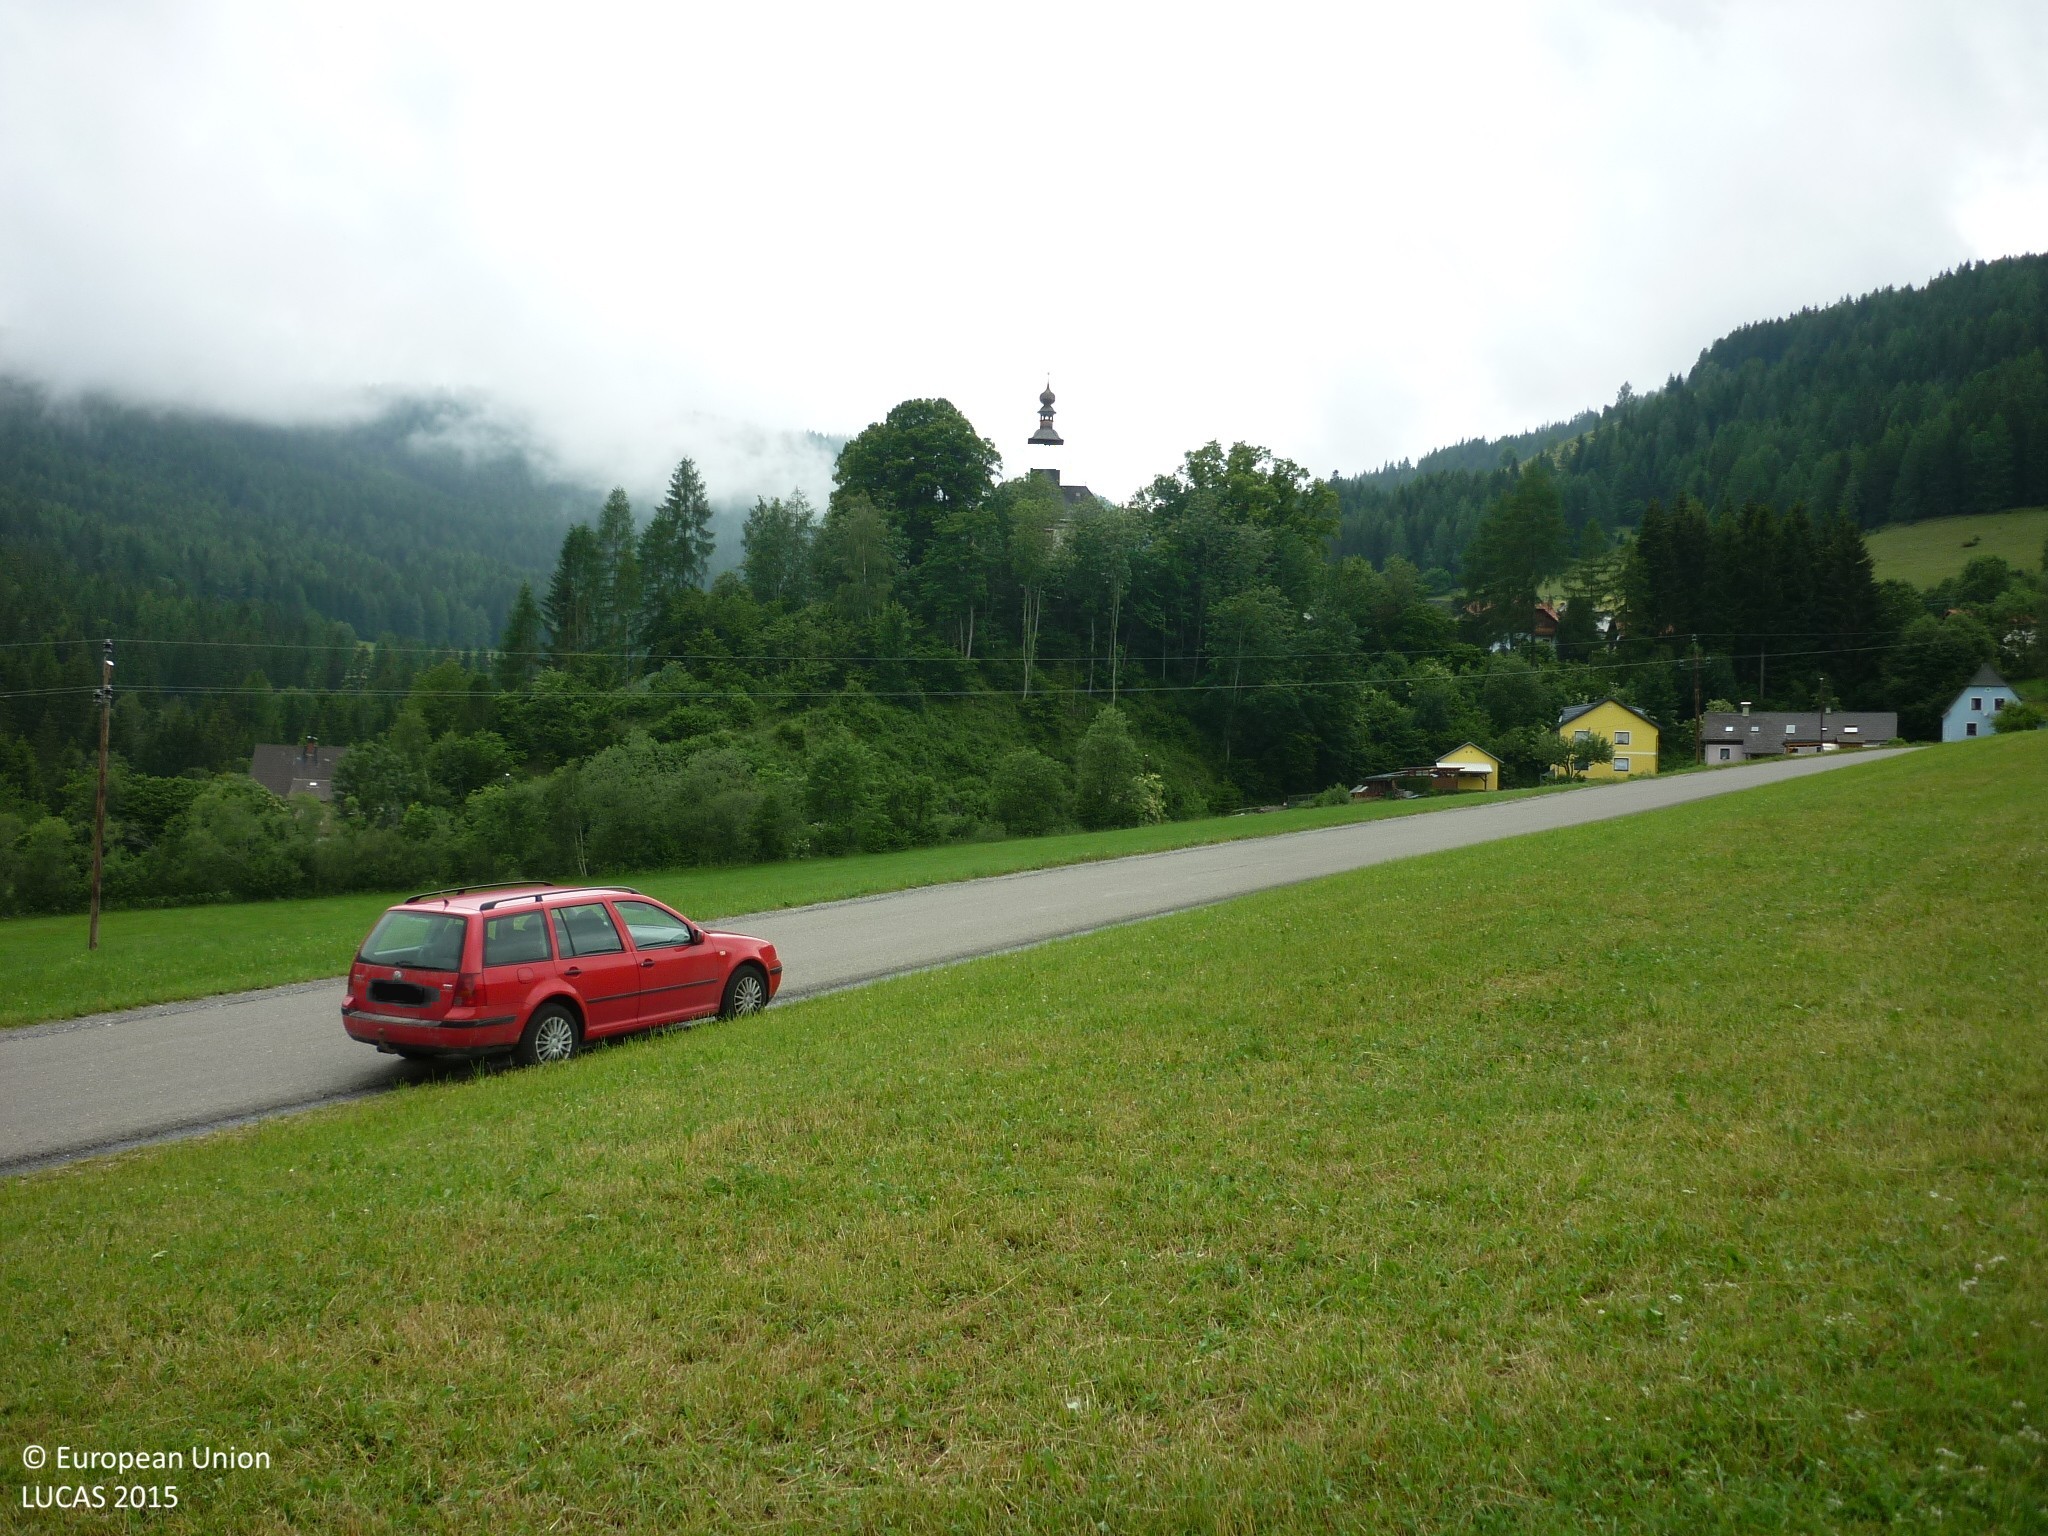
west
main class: Grassland
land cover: Grassland without tree/shrub cover
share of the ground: > 75 %
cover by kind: herbaceous plants 100 %
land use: Agriculture (excluding fallow land and kitchen gardens)
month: June
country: AT
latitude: 47.0940
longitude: 14.3063
